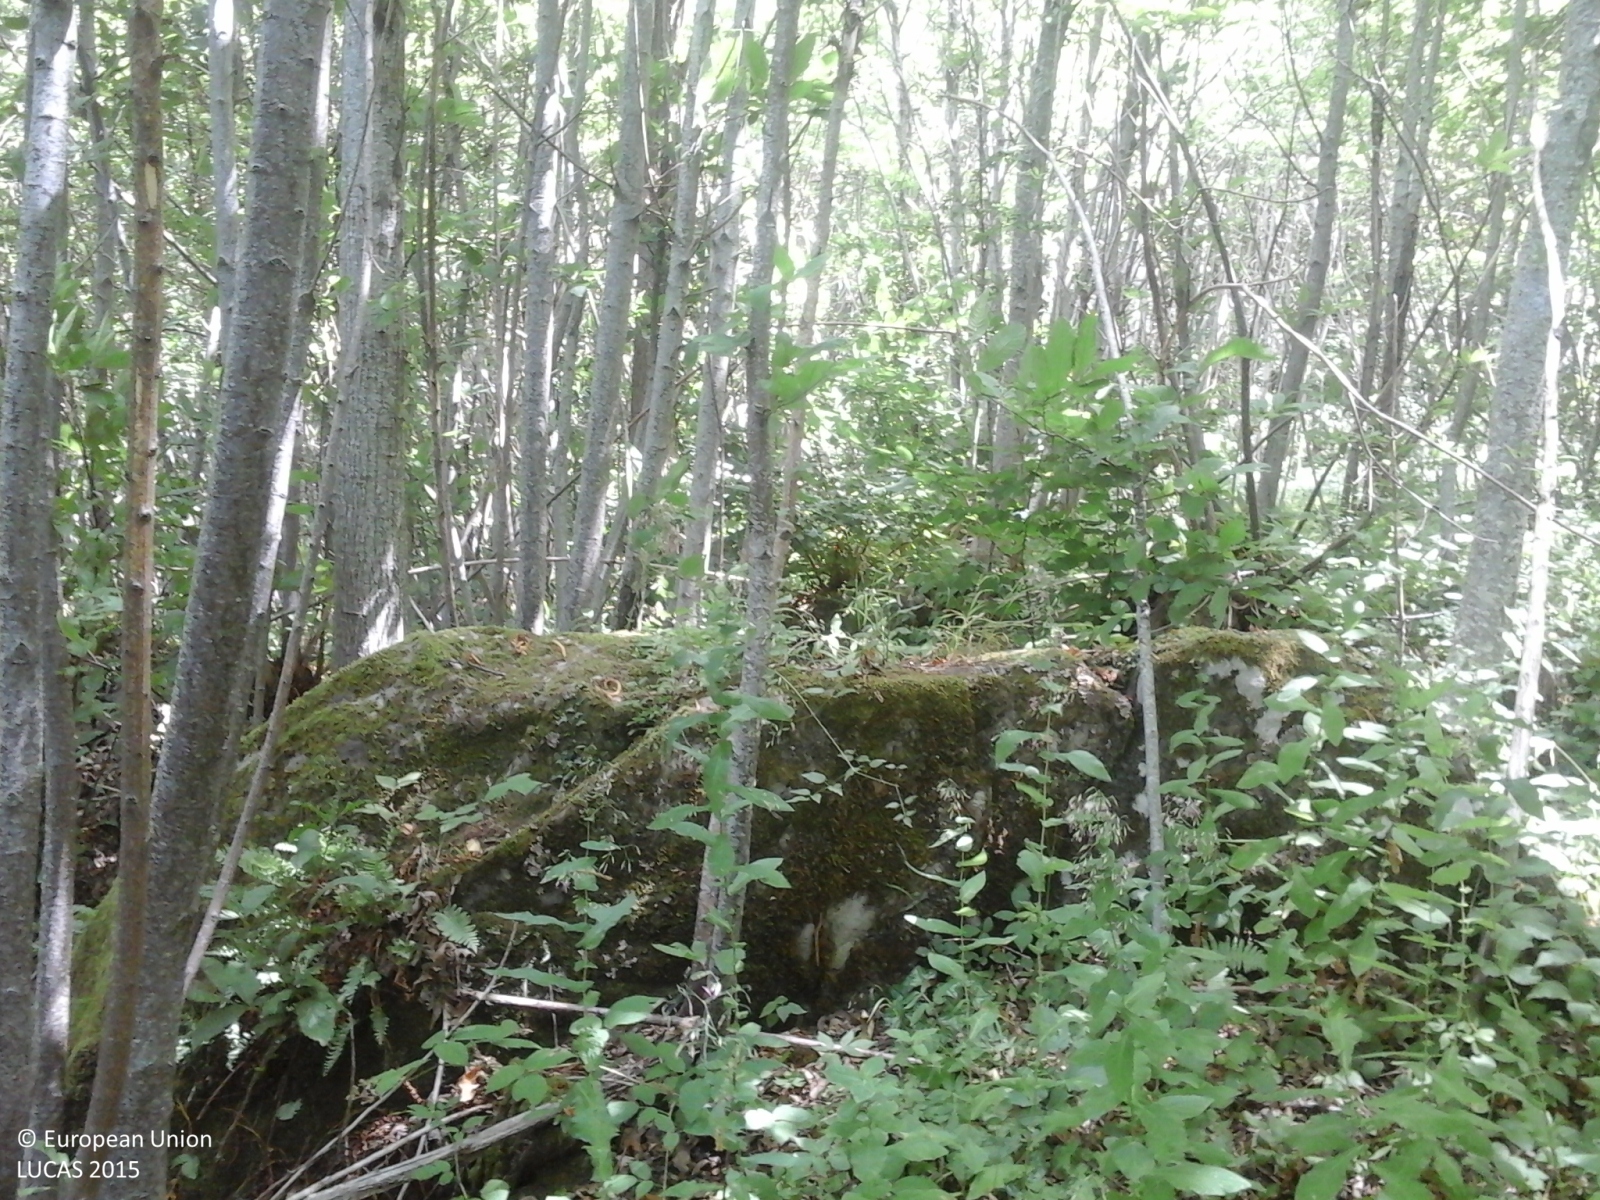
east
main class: Woodland
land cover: Broadleaved woodland
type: mesophytic deciduous forest
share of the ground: > 75 %
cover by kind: broadleaved forest trees 100 %
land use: Forestry
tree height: > 5 m
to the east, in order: Broadleaved woodland
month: July
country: IT
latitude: 43.8576
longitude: 12.2215
